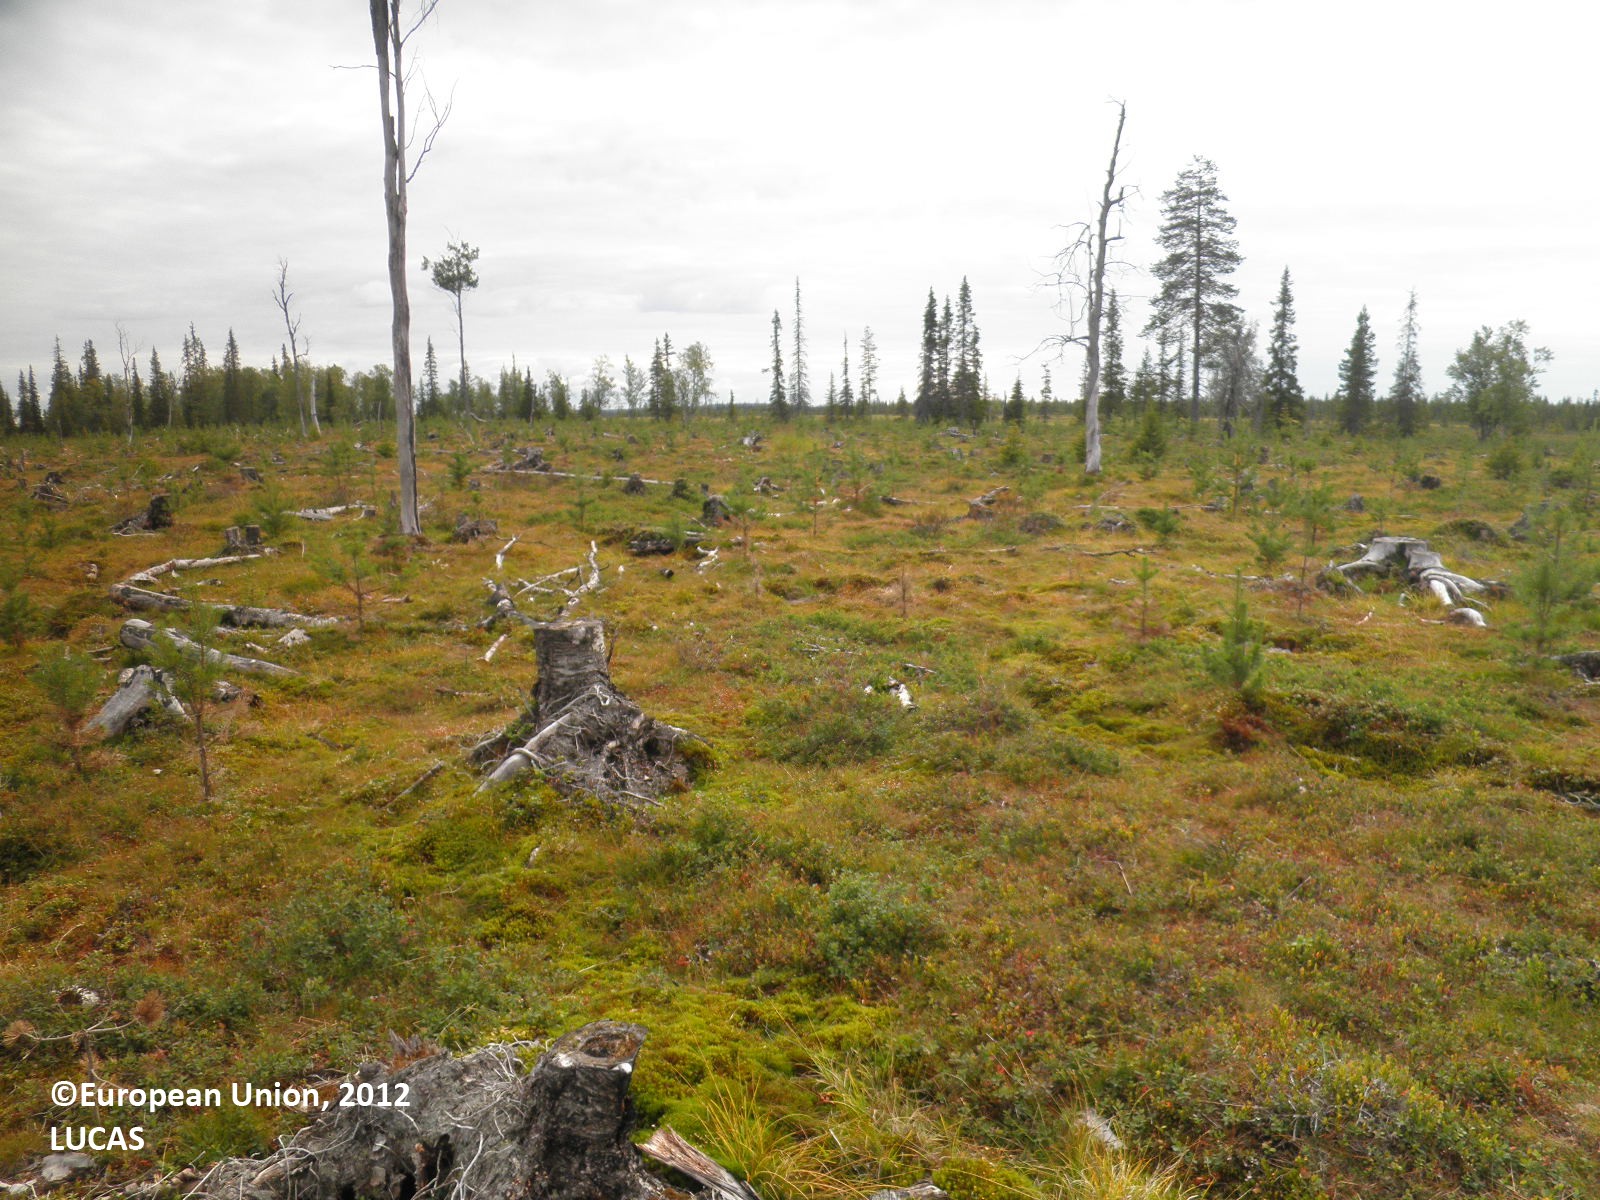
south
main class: Grassland
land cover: Grassland with sparse tree/shrub cover
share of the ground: > 75 %
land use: Forestry
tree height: < 5 m
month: August
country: FI
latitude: 67.7609
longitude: 26.3288
